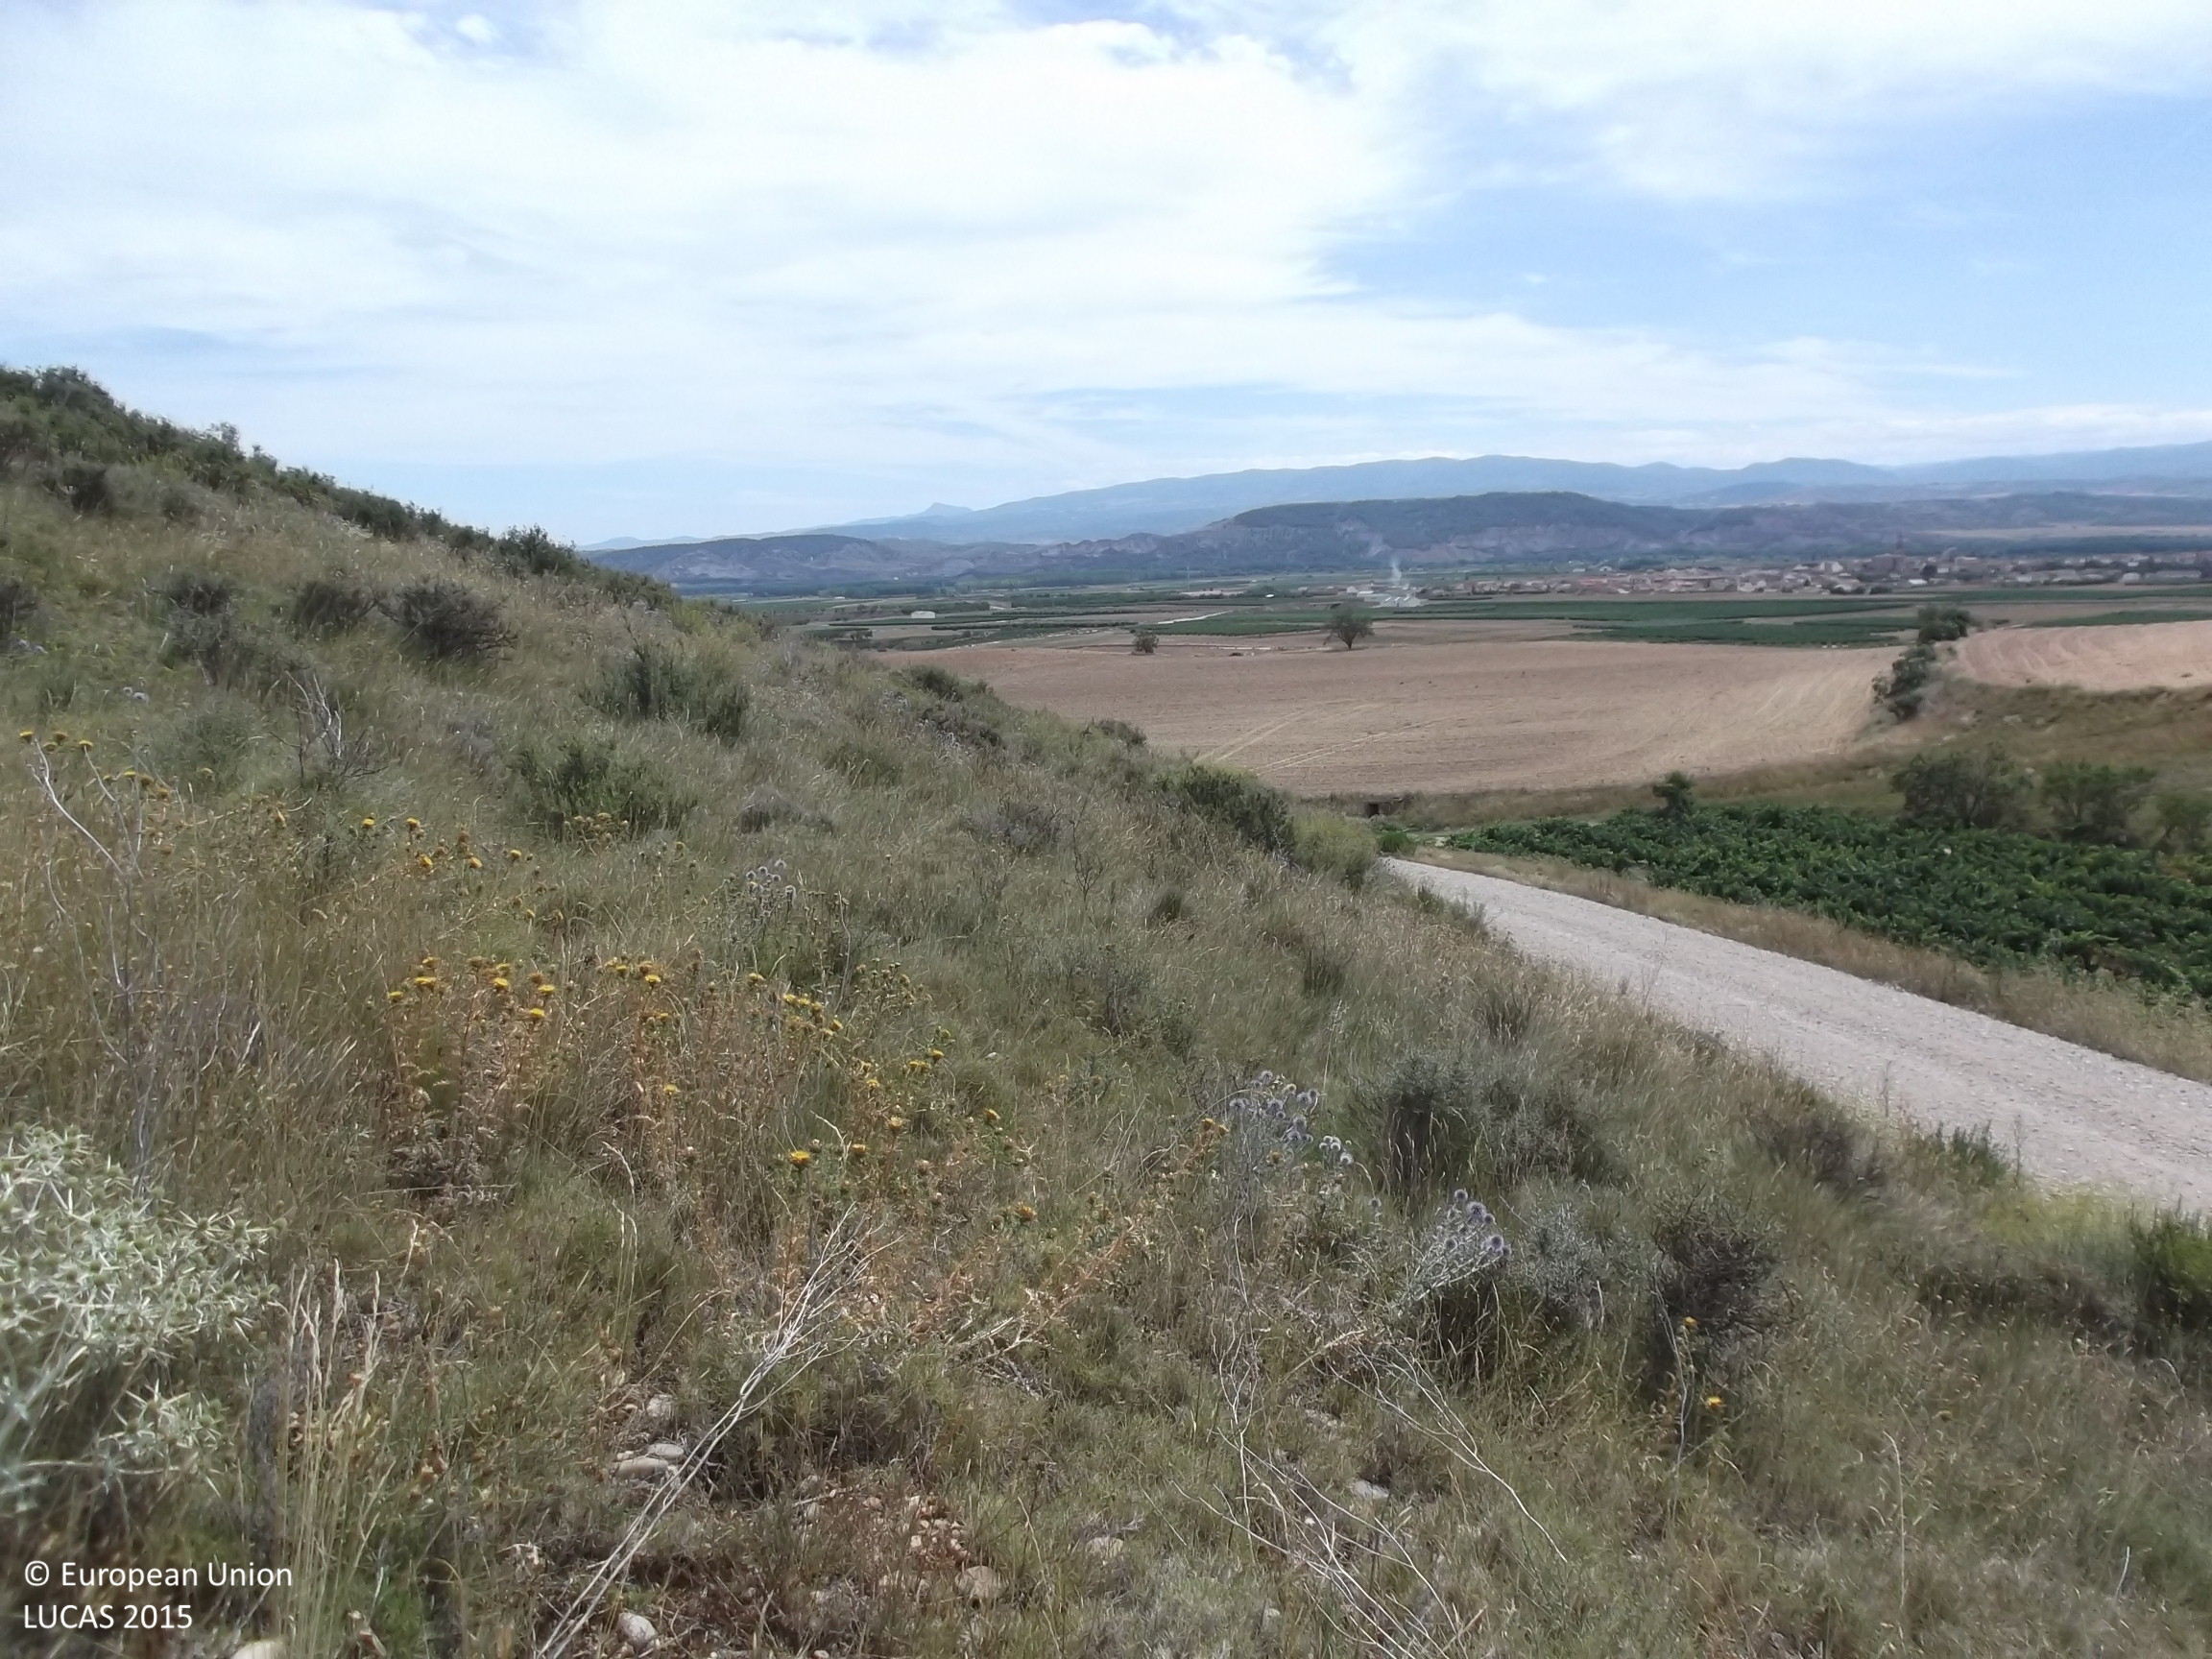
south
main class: Shrubland
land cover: Shrubland without tree cover
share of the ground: 50 - 75 %
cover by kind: shrubs 60 %, herbaceous plants 30 %, lichens and mosses 5 %
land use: Semi-natural and natural areas not in use
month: August
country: ES
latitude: 42.4620
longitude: -2.1908
